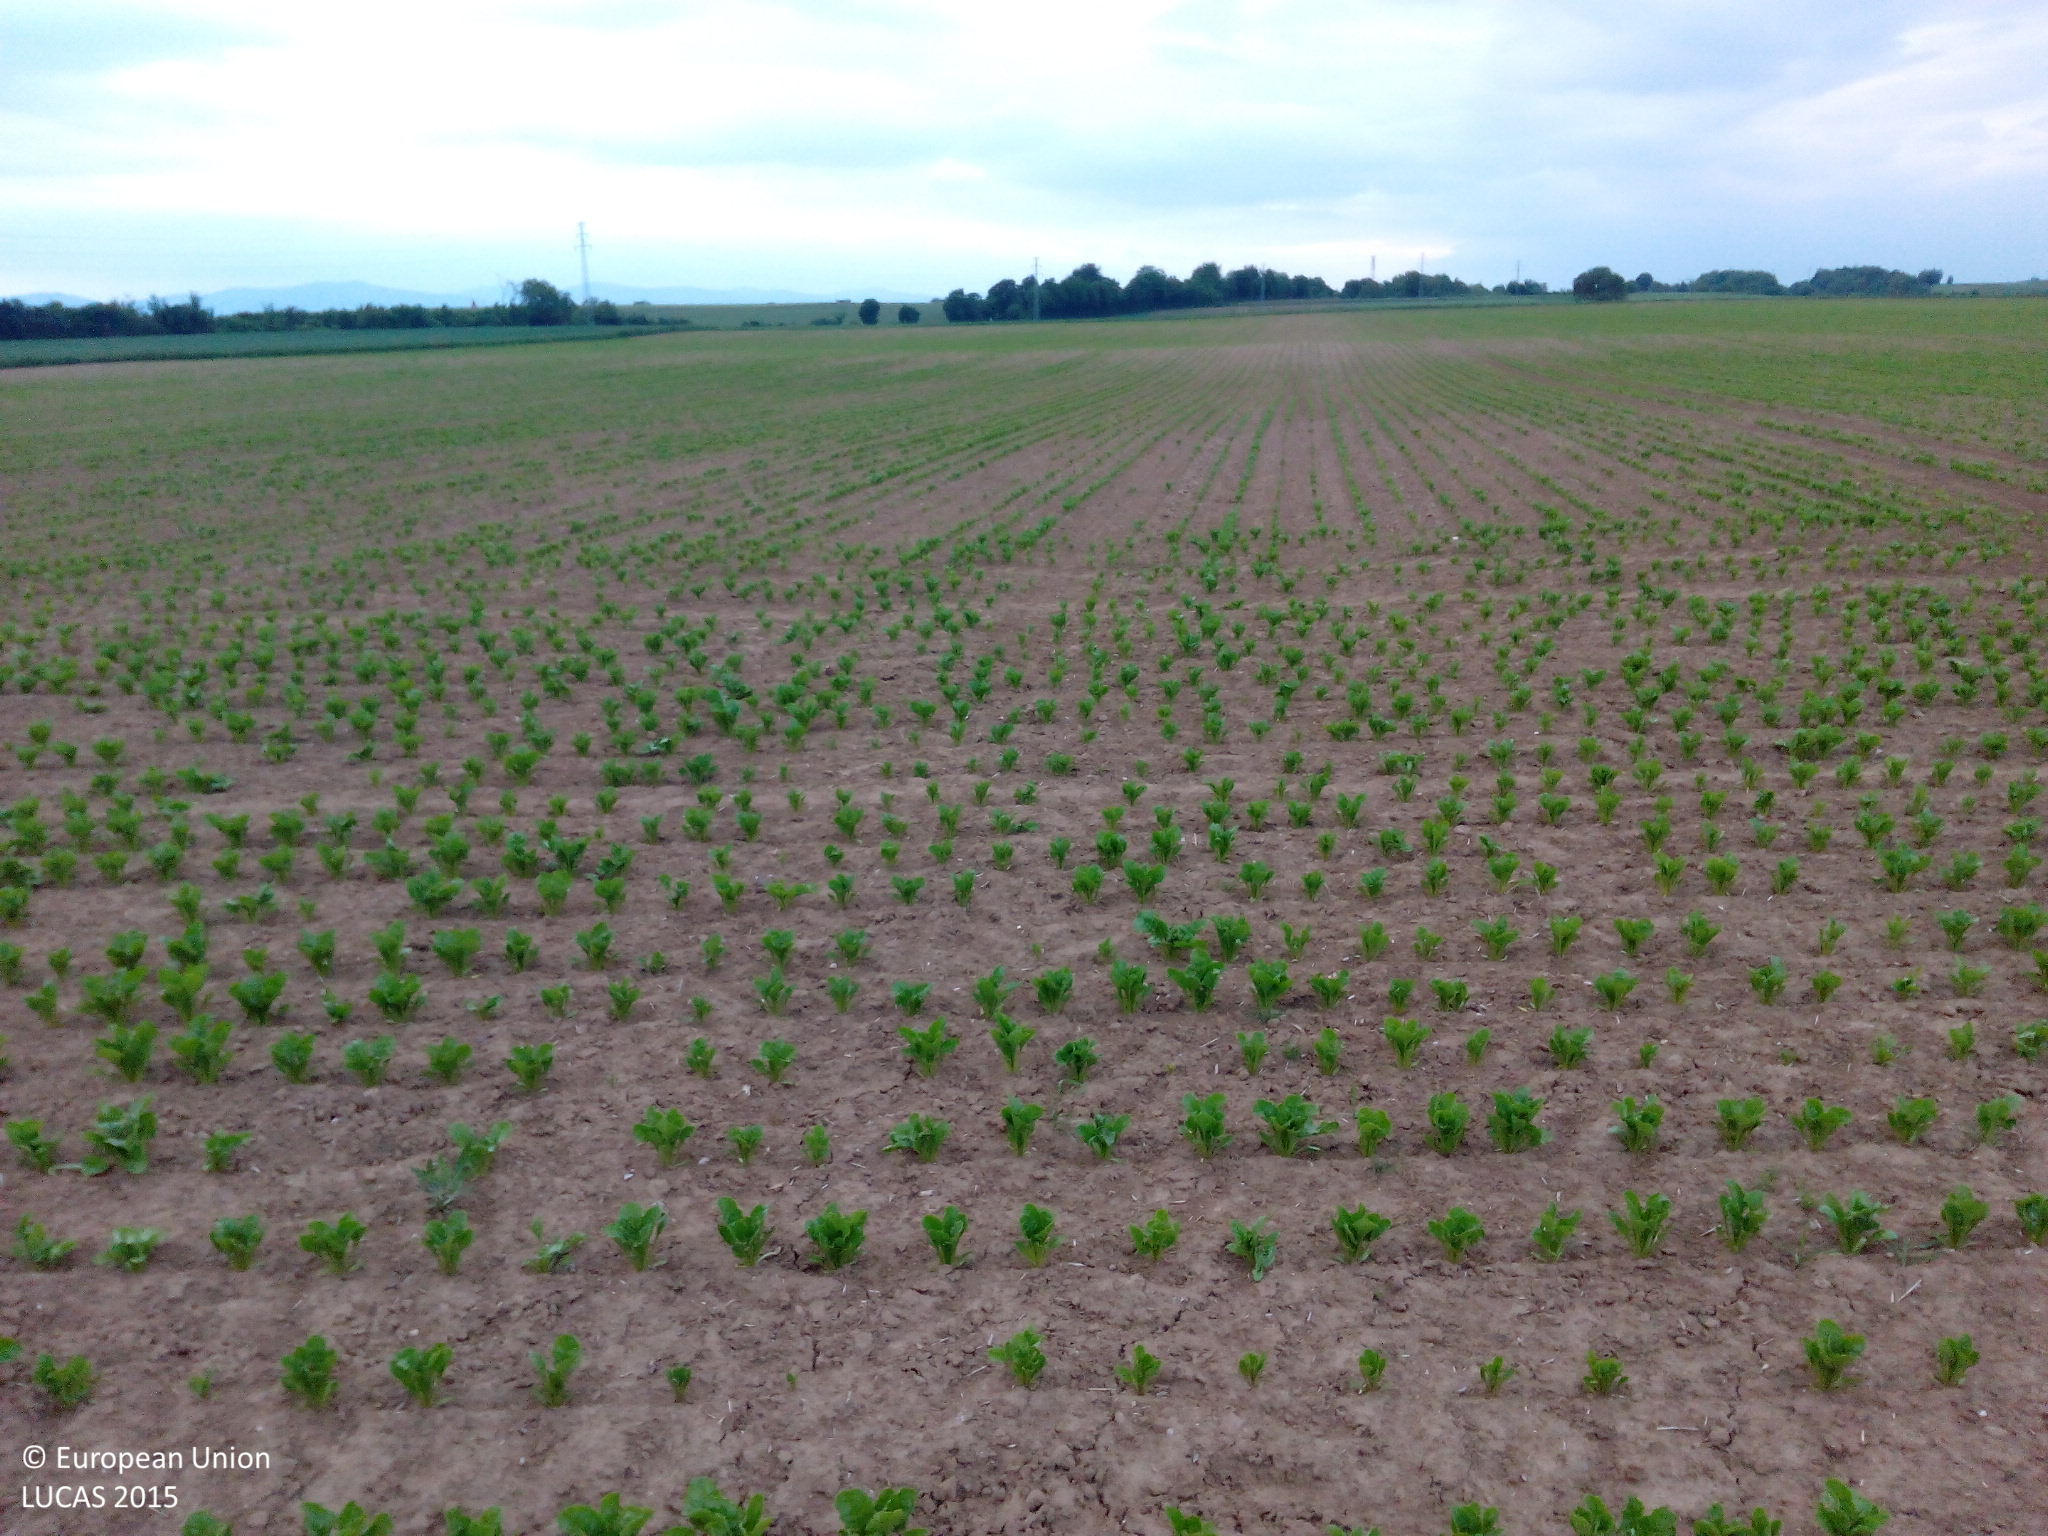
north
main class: Cropland
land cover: Sugar beet
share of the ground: < 10 %
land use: Agriculture (excluding fallow land and kitchen gardens)
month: May
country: DE
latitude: 49.1438
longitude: 8.1499
